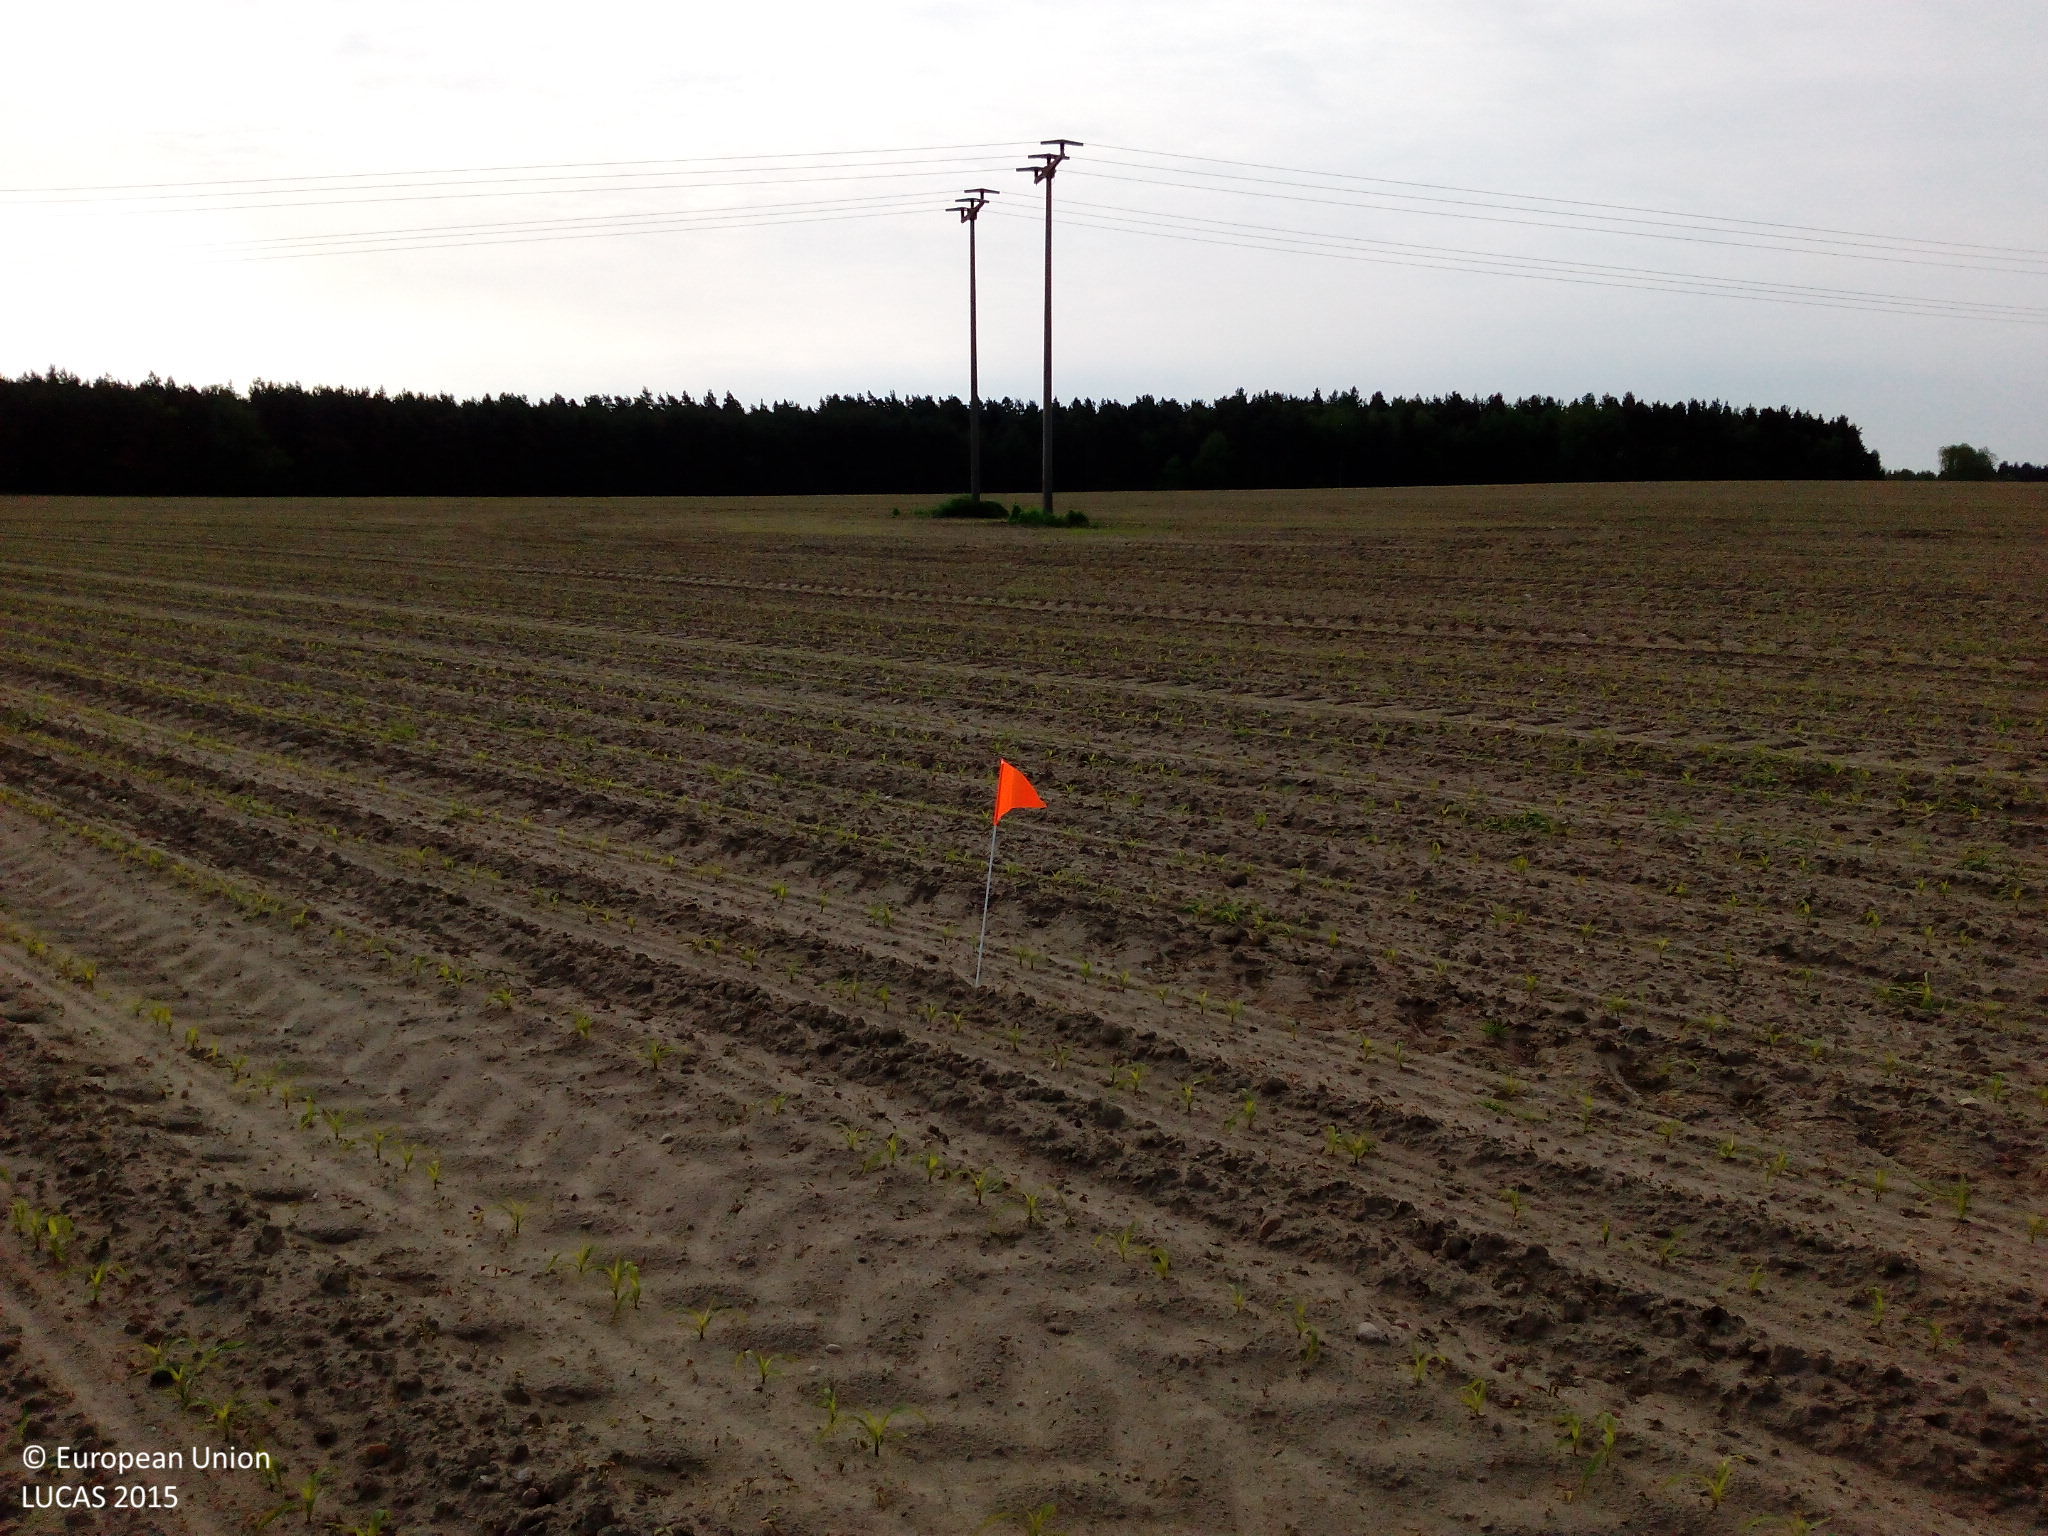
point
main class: Cropland
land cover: Maize
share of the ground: < 10 %
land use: Agriculture (excluding fallow land and kitchen gardens)
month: May
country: DE
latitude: 52.8214
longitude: 11.1422
